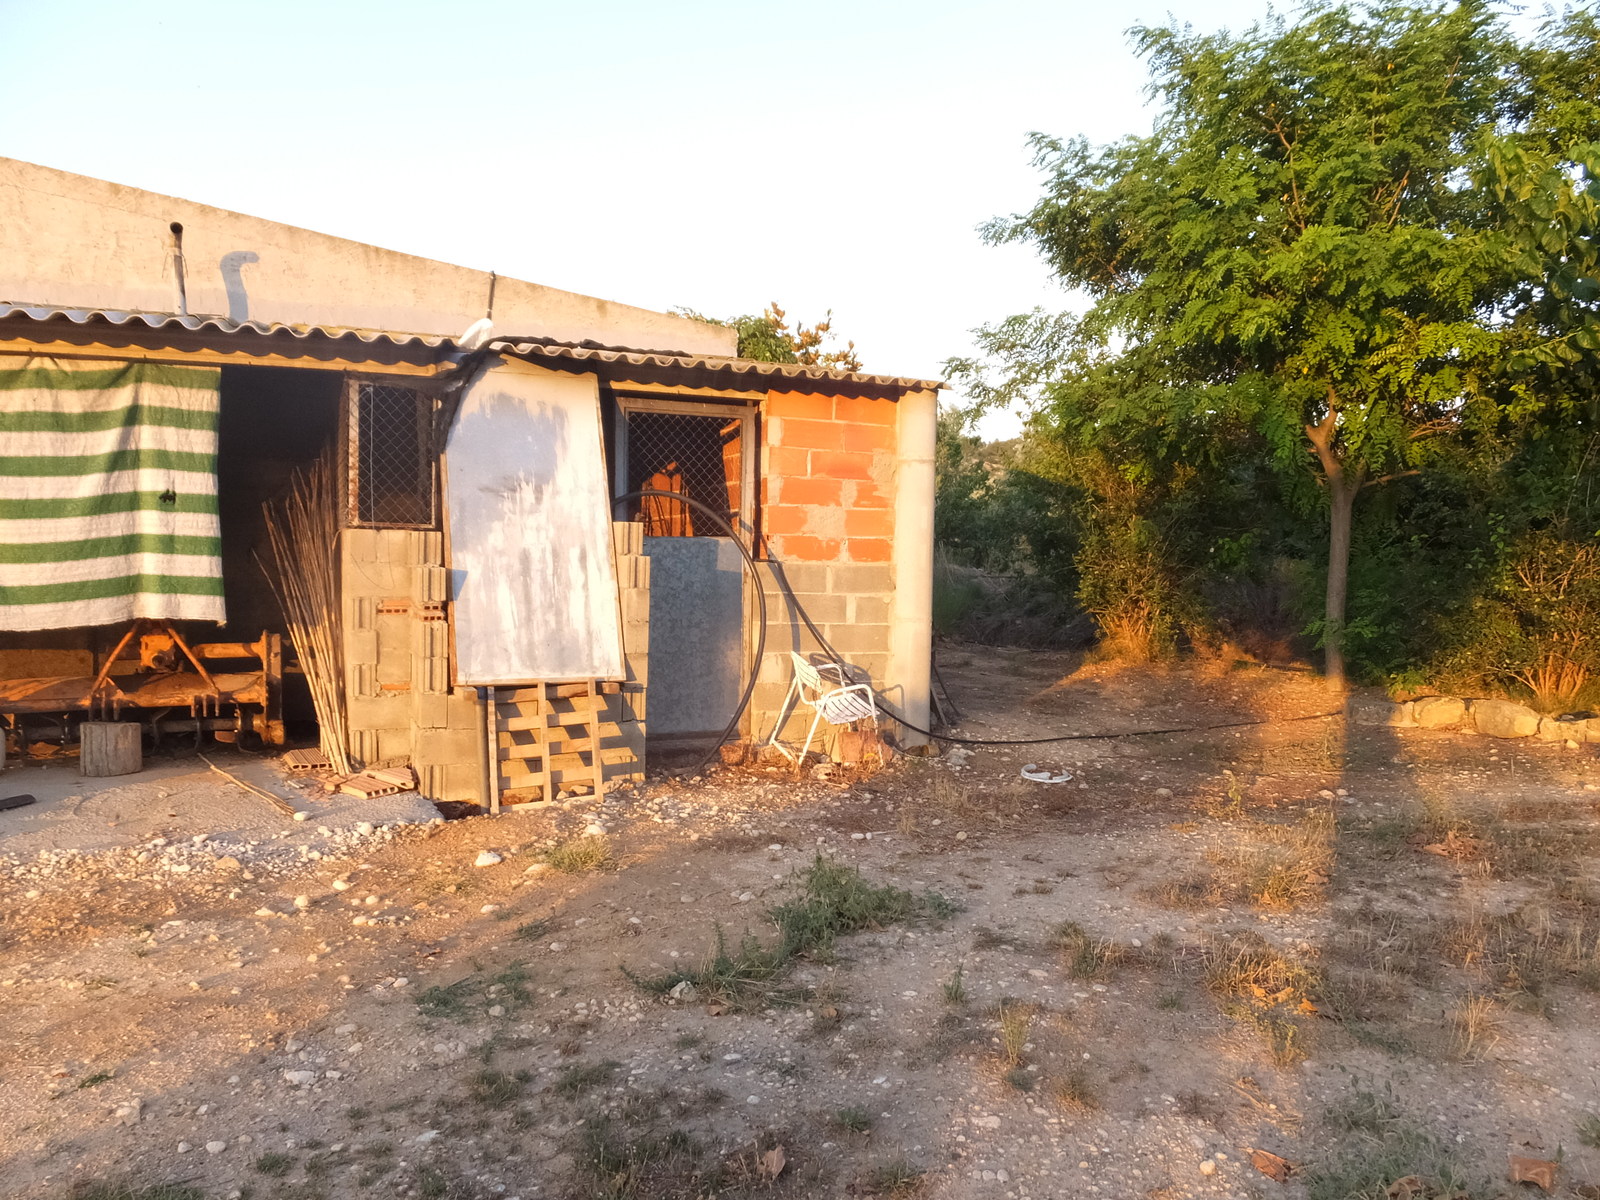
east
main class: Grassland
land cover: Grassland without tree/shrub cover
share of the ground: > 75 %
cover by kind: herbaceous plants 100 %
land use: Logistics and storage
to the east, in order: Grassland without tree/shrub cover; Artificial constructions in urban areas; Grassland with sparse tree/shrub cover; Ditches and canals; Shruby margins; Olive groves; Shruby margins; Olive groves; Shruby margins; Olive groves; Shruby margins; Tracks; Shruby margins; Ditches and canals; Shruby margins; Other fruit trees and berries; Shruby margins; Ditches and canals; Shruby margins; Other fruit trees and berries; Shruby margins
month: July
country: ES
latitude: 41.0787
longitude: 0.1224
